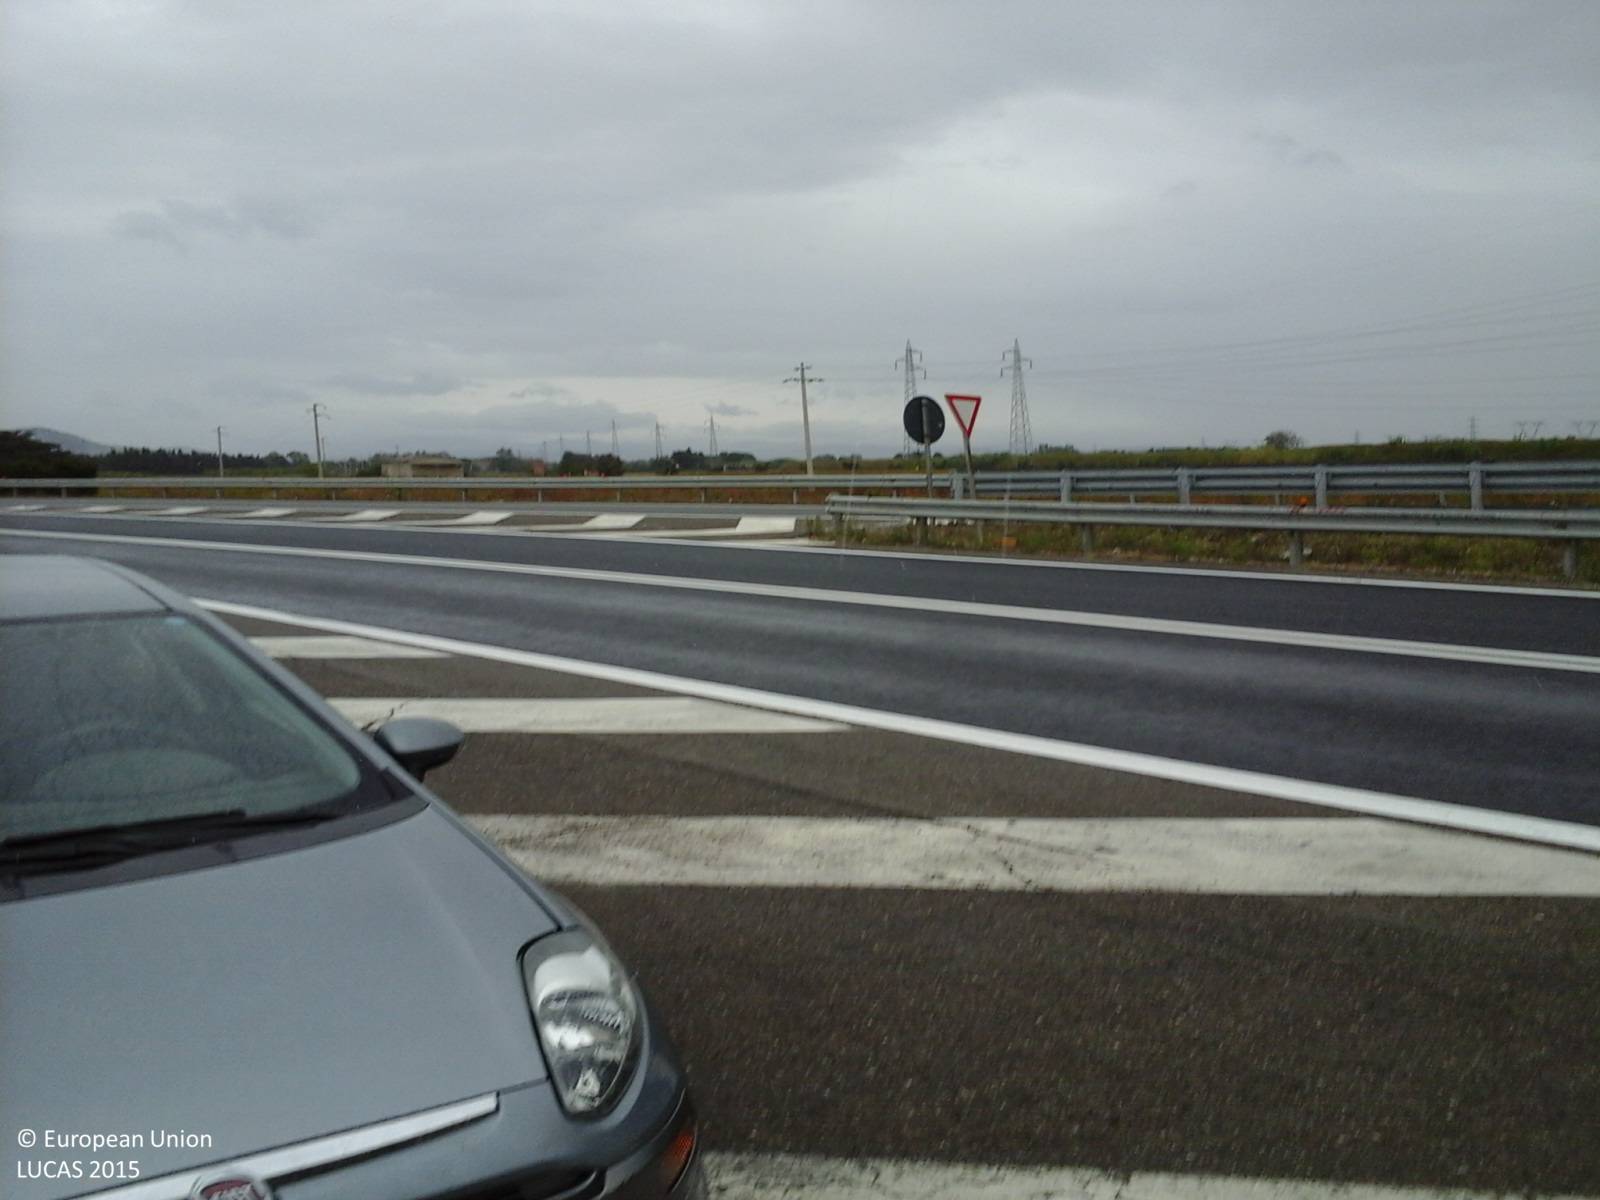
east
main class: Grassland
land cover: Grassland without tree/shrub cover
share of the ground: > 75 %
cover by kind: herbaceous plants 100 %
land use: Road transport
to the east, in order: Grassland without tree/shrub cover; Paved roads, cycling and walking lanes; Grassland without tree/shrub cover; Paved roads, cycling and walking lanes; Grassland without tree/shrub cover; Paved roads, cycling and walking lanes; Ditches and canals; Grassland without tree/shrub cover
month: October
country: IT
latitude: 43.0134
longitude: 10.5993
